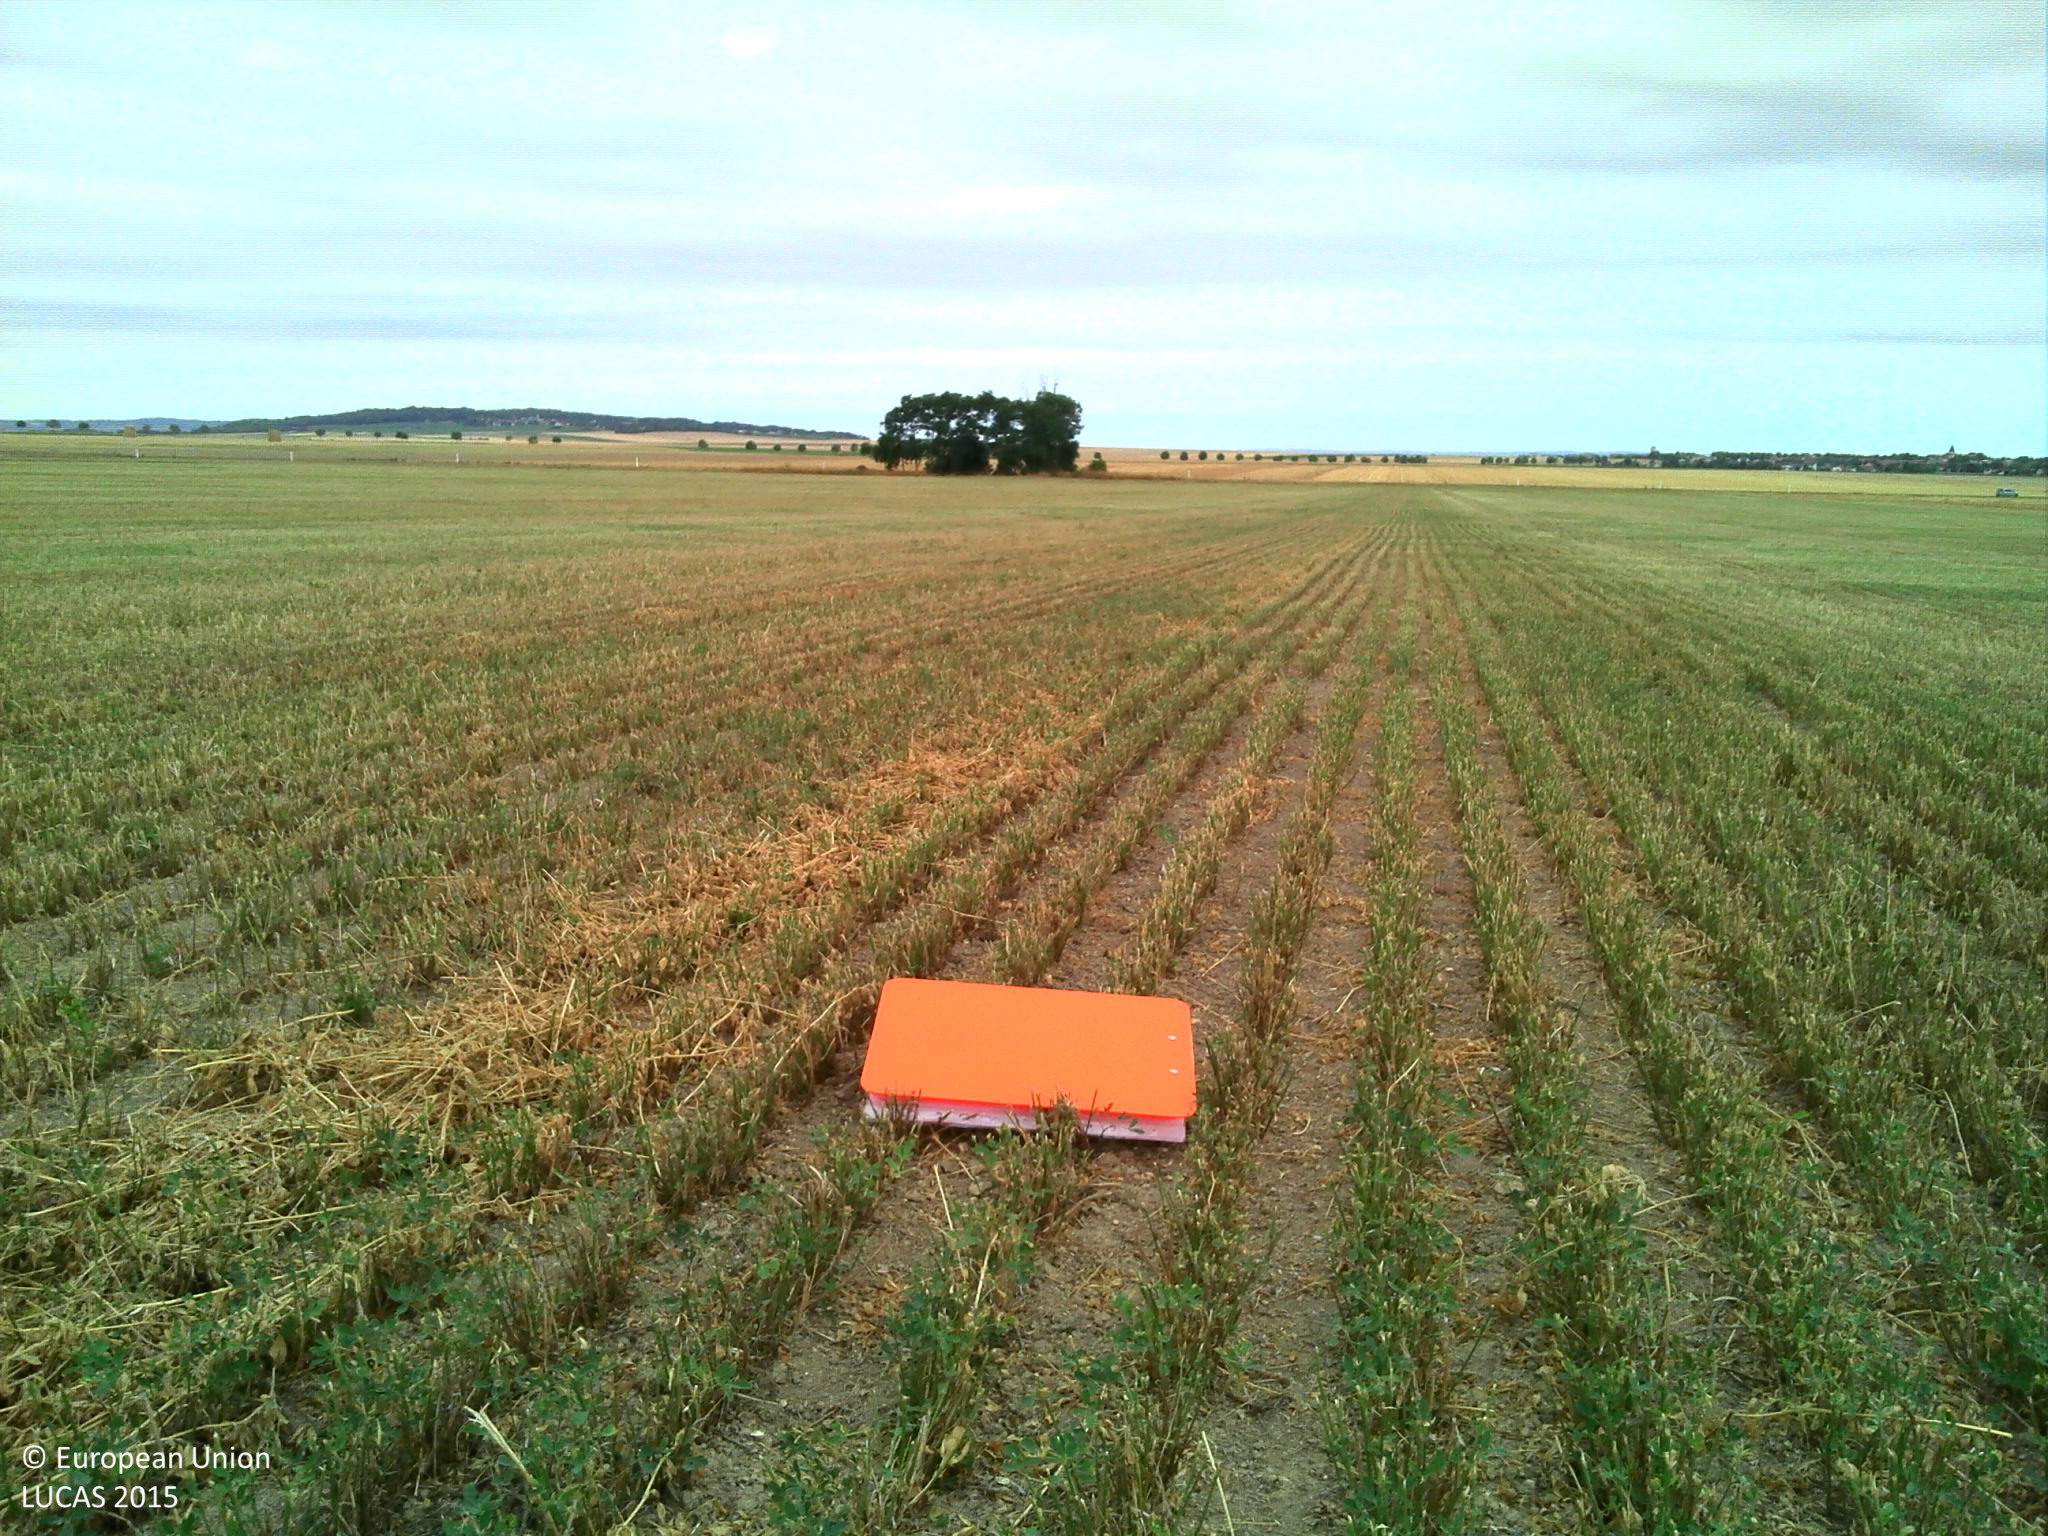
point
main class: Cropland
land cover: Lucerne
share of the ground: > 75 %
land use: Agriculture (excluding fallow land and kitchen gardens)
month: July
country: FR
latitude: 49.3278
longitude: 4.0923
